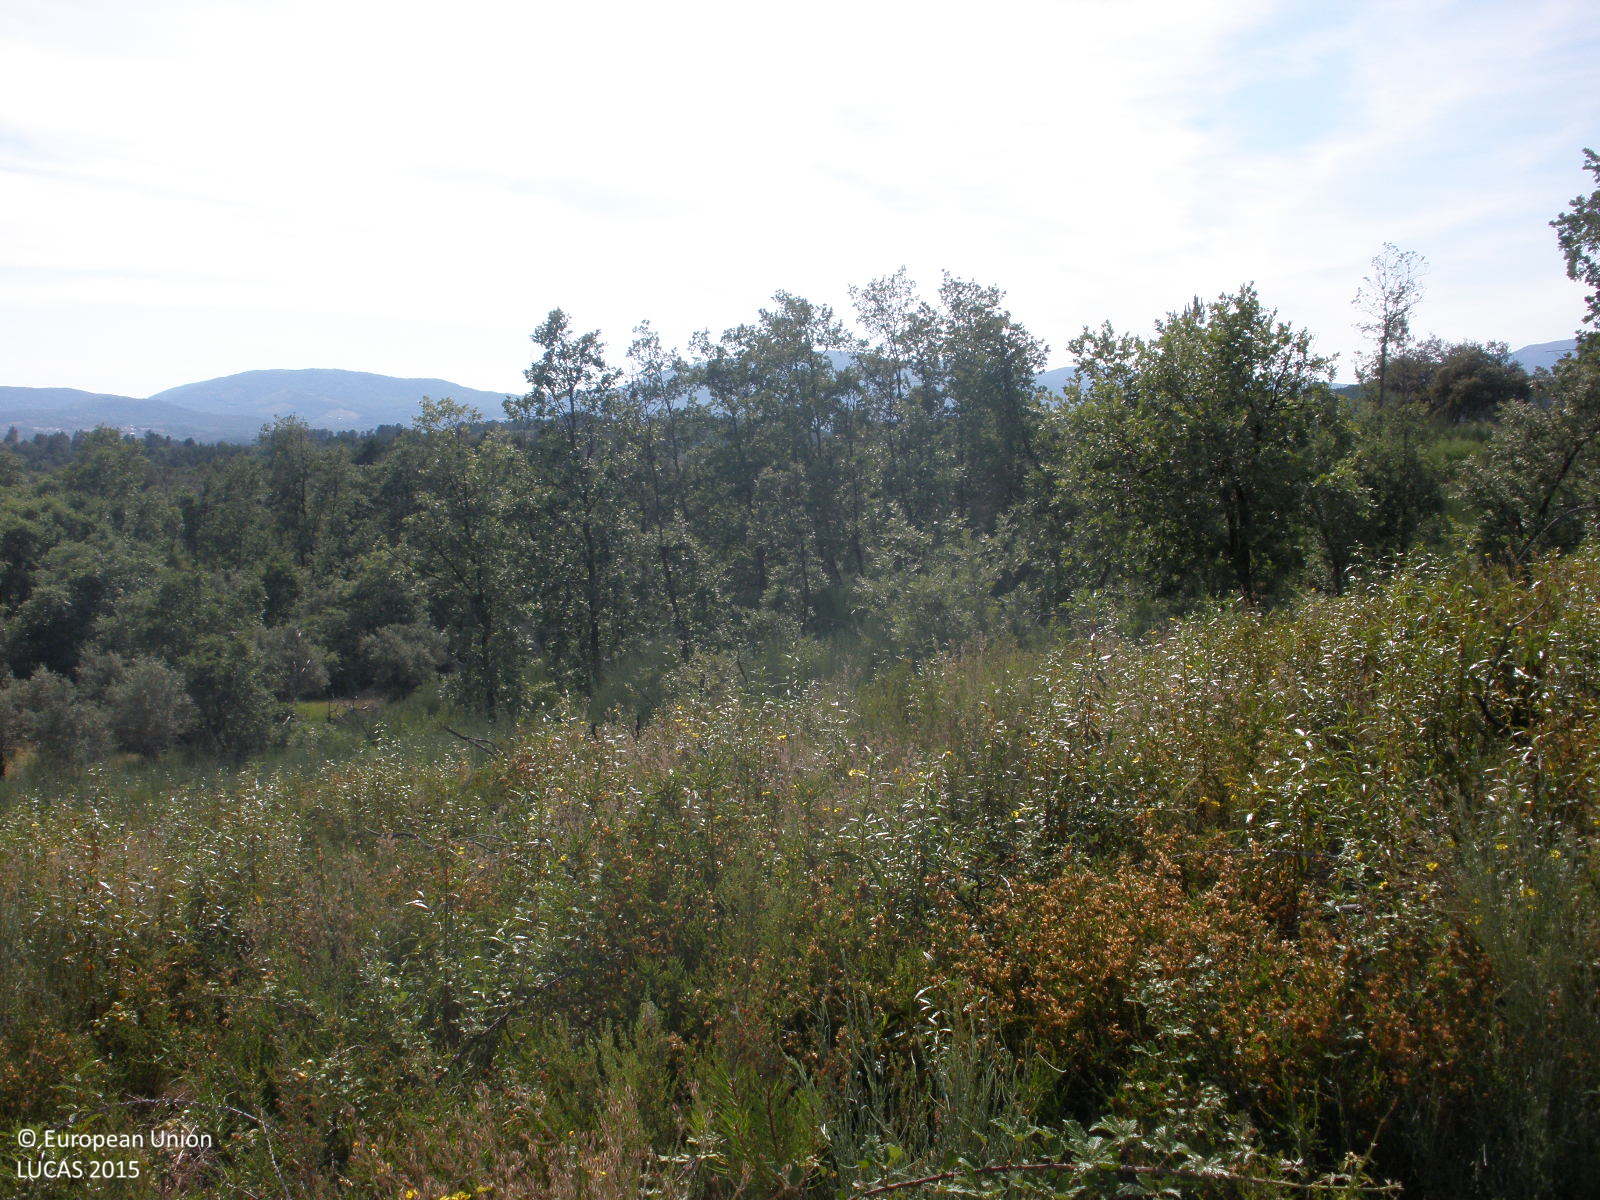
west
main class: Shrubland
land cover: Shrubland without tree cover
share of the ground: > 75 %
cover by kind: shrubs 100 %
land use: Semi-natural and natural areas not in use
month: May
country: ES
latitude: 40.1851
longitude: -6.6101
